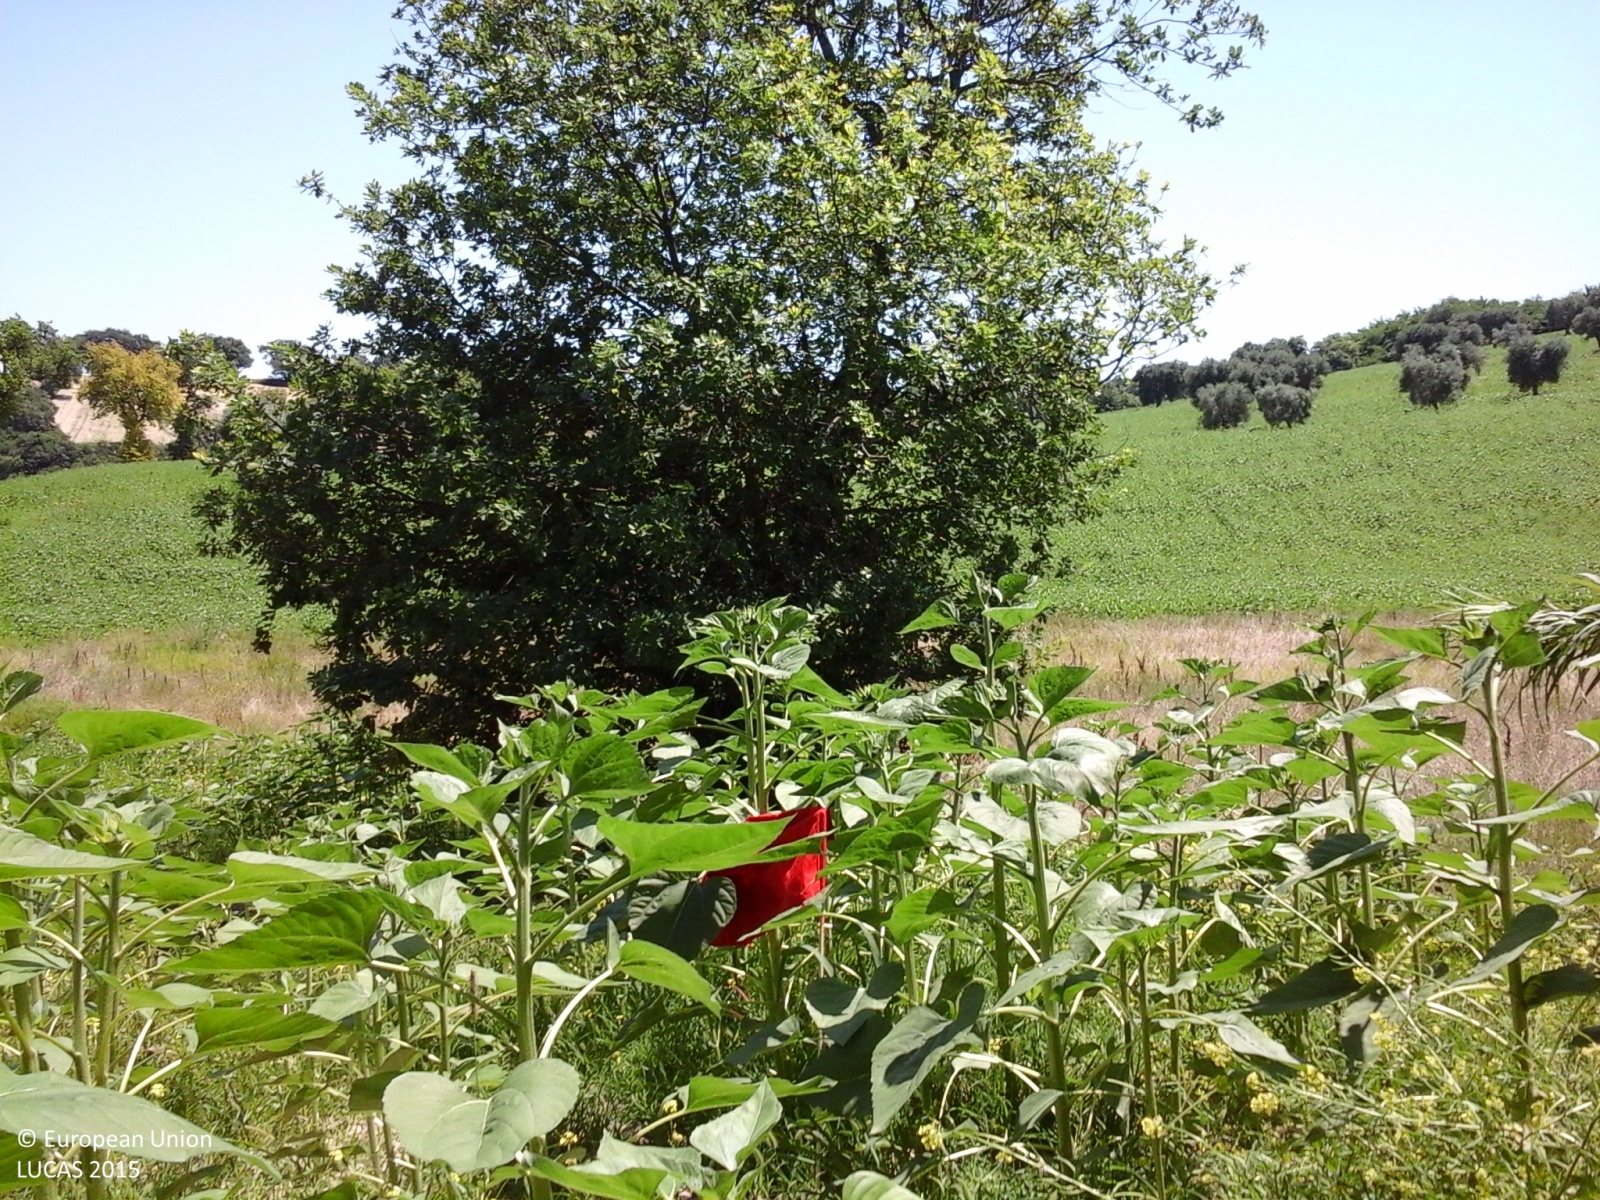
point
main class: Cropland
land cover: Sunflower
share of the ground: > 75 %
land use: Agriculture (excluding fallow land and kitchen gardens)
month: July
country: IT
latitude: 43.3604
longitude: 13.2615
